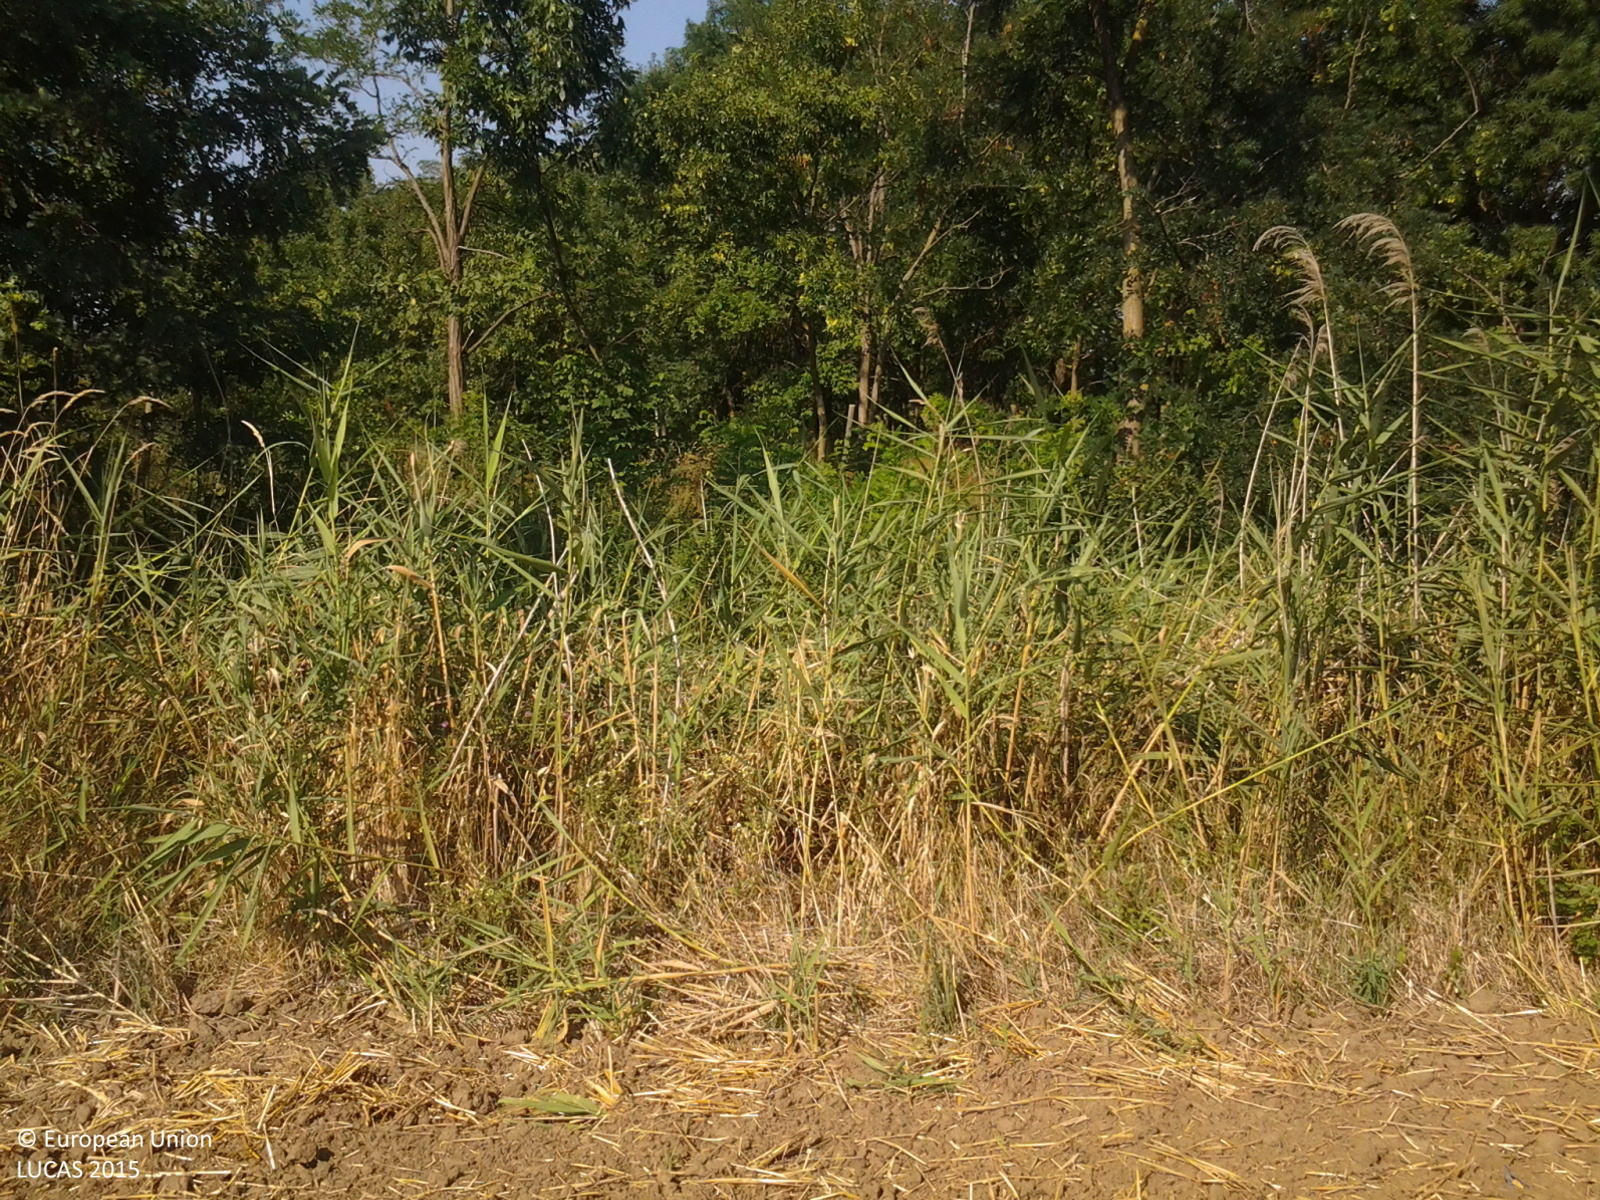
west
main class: Cropland
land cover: Common wheat
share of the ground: < 10 %
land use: Agriculture (excluding fallow land and kitchen gardens)
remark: Harvested field
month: August
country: HU
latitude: 46.9282
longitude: 21.5057
